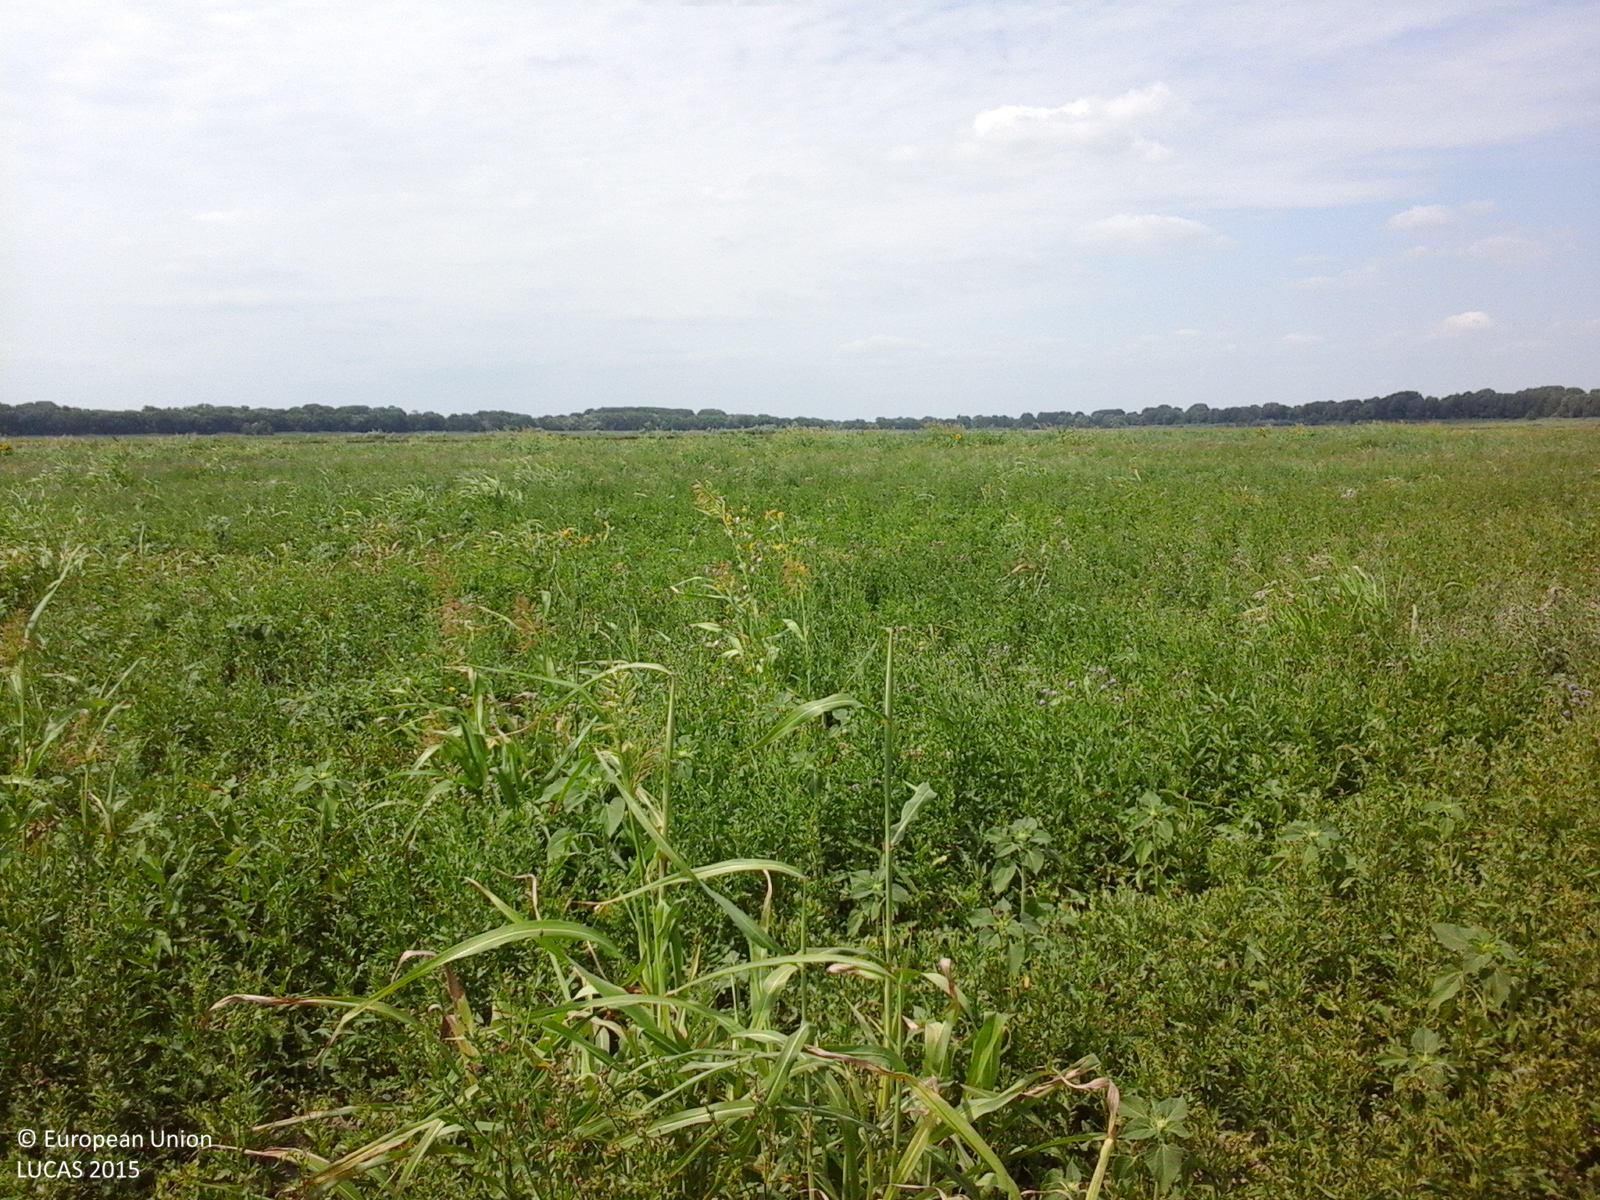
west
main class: Grassland
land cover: Spontaneously vegetated surfaces
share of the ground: > 75 %
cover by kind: herbaceous plants 100 %
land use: Fallow land
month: August
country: RO
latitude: 45.3280
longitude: 28.8089
